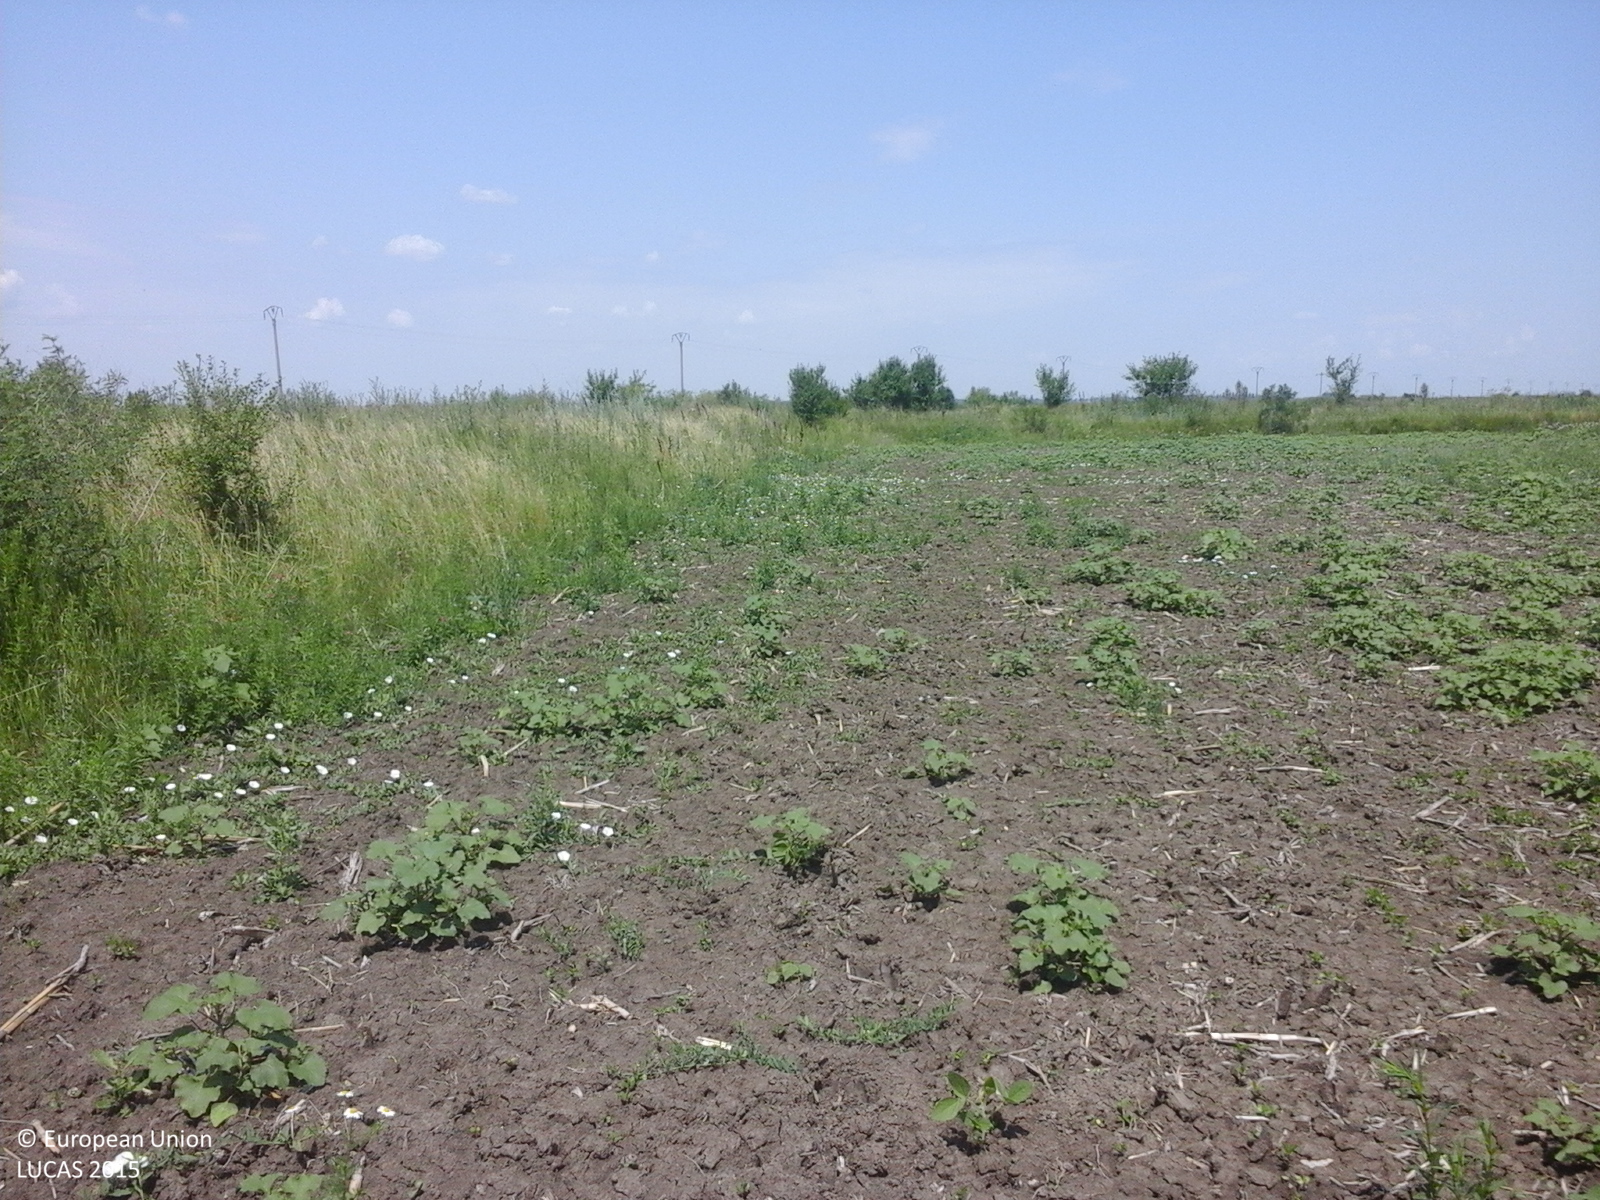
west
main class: Cropland
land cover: Soya
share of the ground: < 10 %
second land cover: Spontaneously vegetated surfaces
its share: 25 - 50 %
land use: Agriculture (excluding fallow land and kitchen gardens)
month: June
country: RO
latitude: 44.0674
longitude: 26.6064
